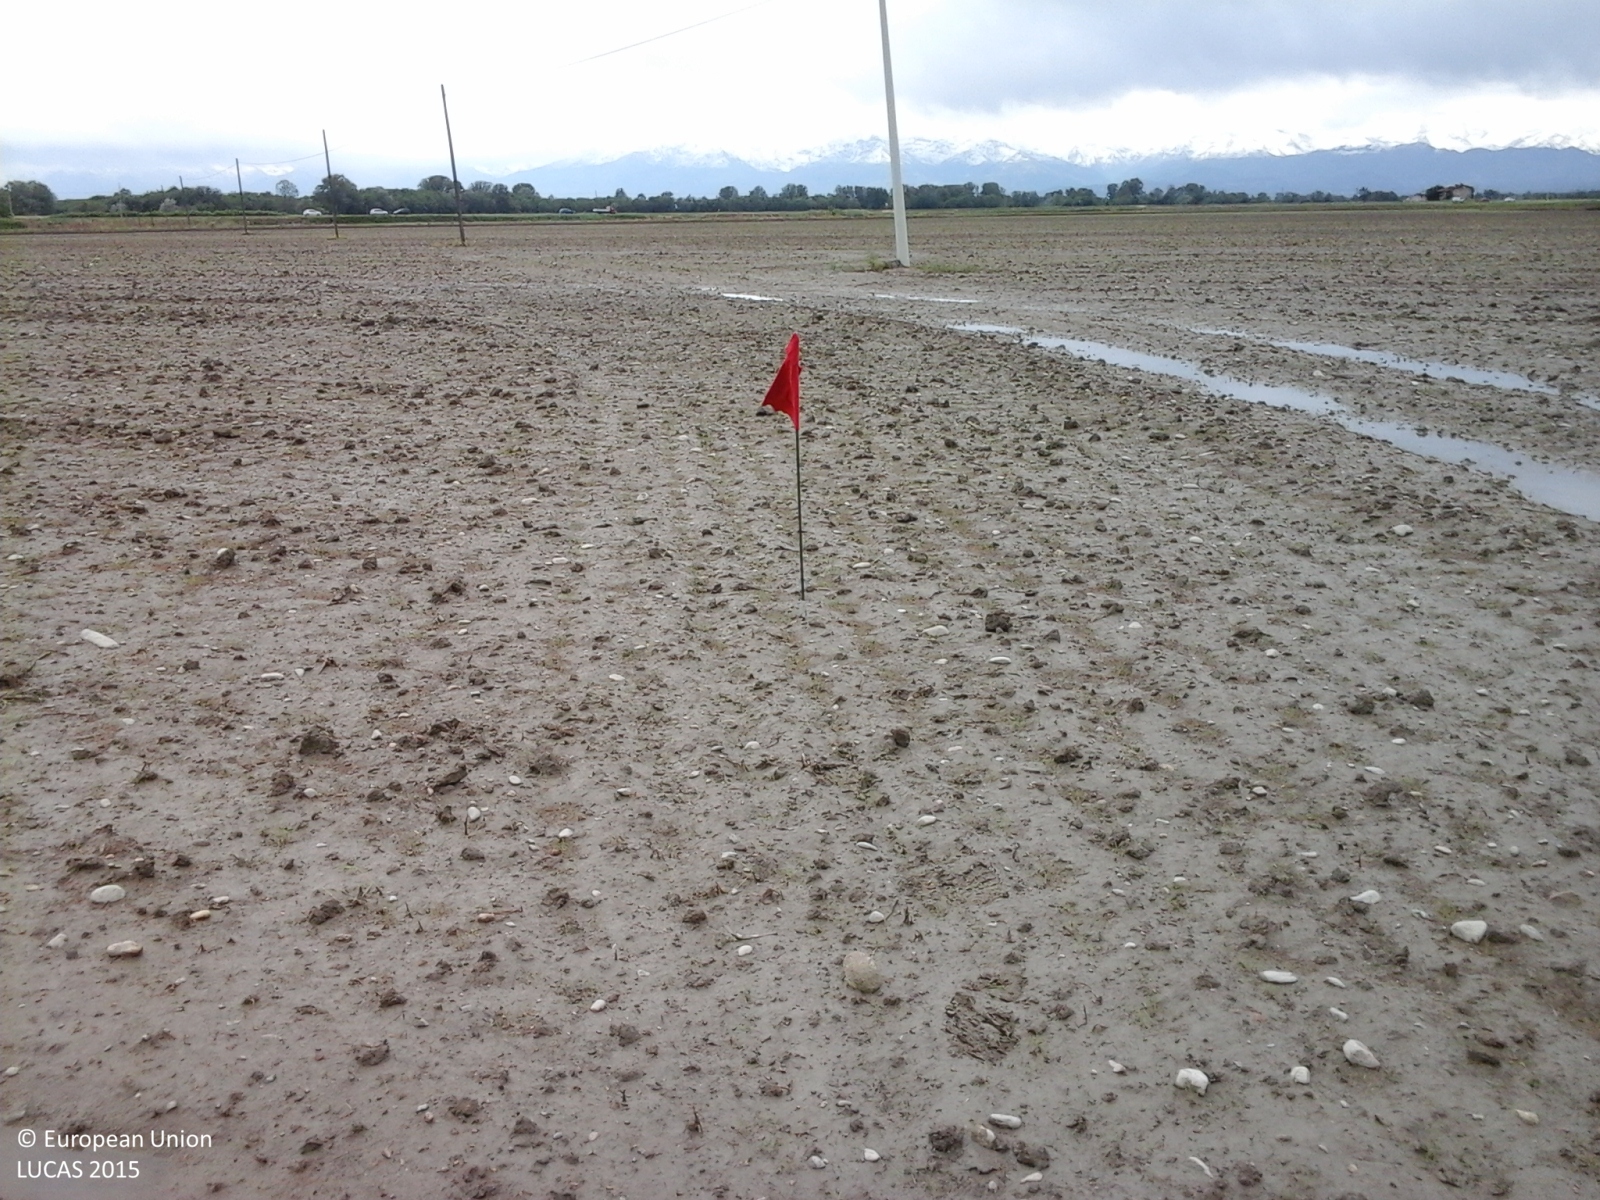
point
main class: Cropland
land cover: Rice
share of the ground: < 10 %
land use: Agriculture (excluding fallow land and kitchen gardens)
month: May
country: IT
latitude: 45.3838
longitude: 8.3808
